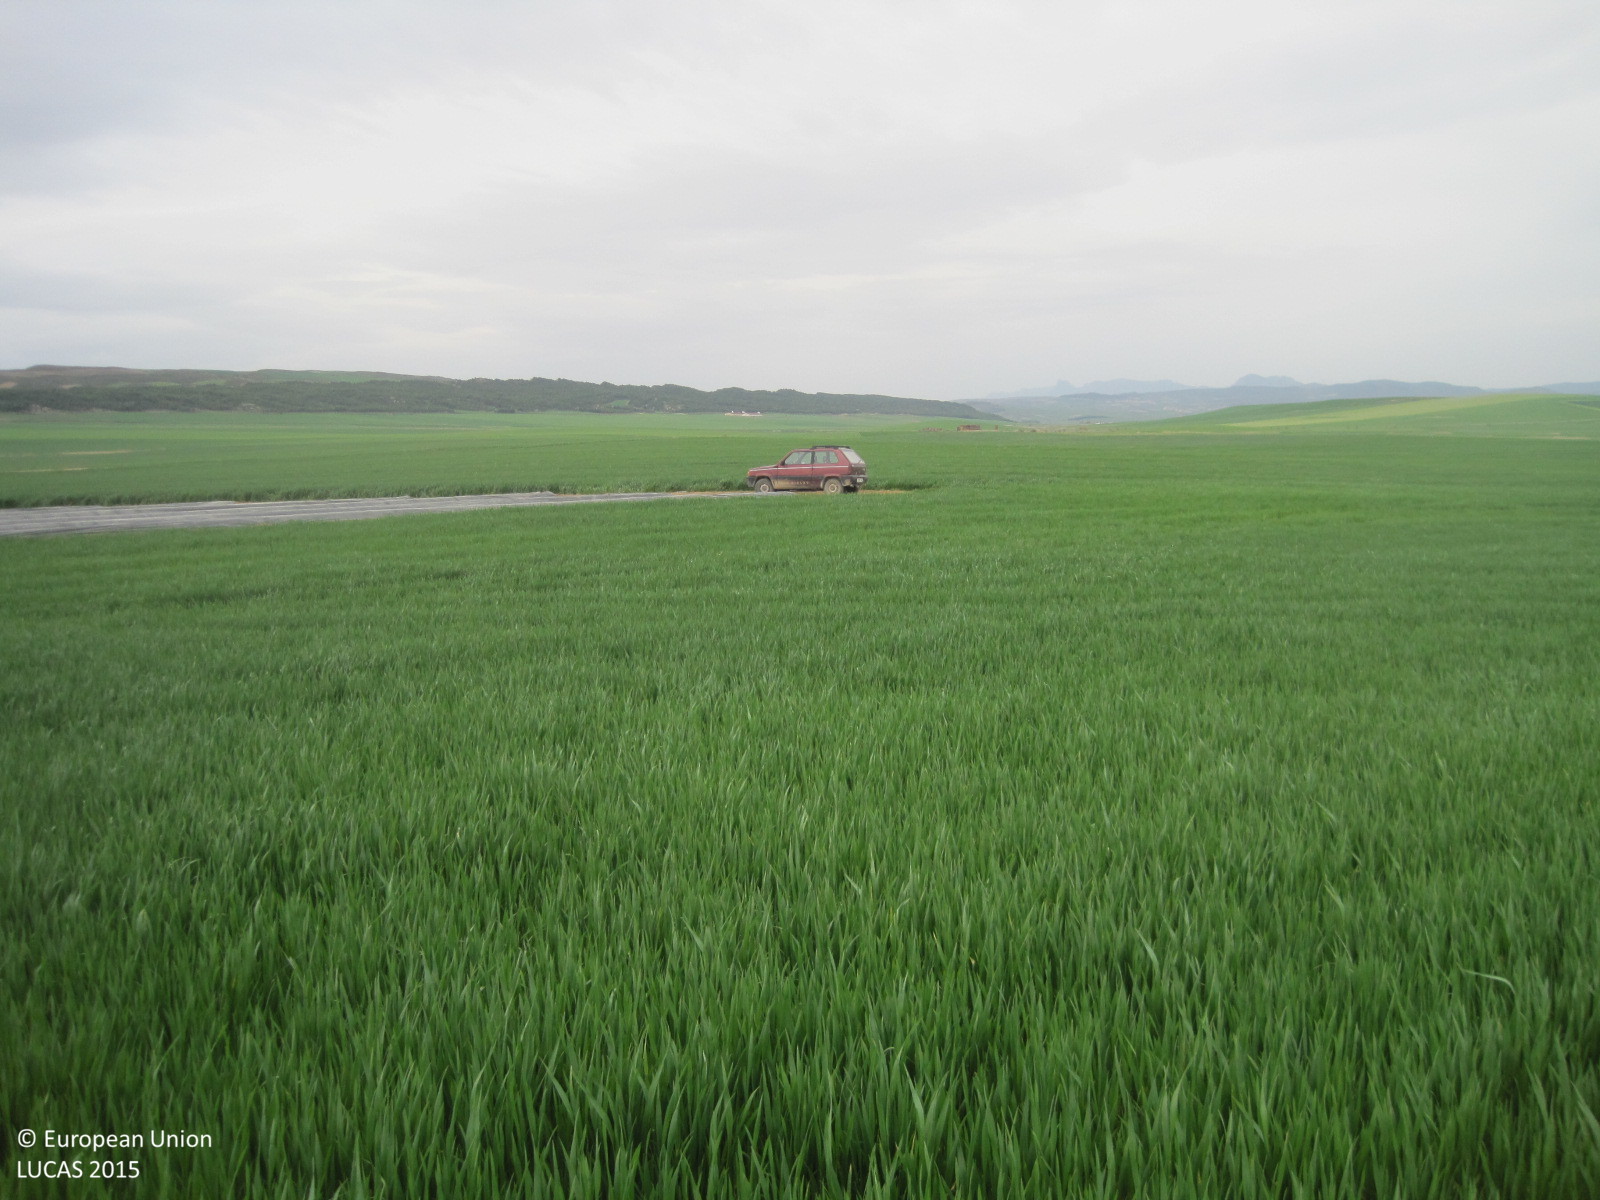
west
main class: Cropland
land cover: Barley
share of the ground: > 75 %
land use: Agriculture (excluding fallow land and kitchen gardens)
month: April
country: ES
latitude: 42.5241
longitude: -2.1297
